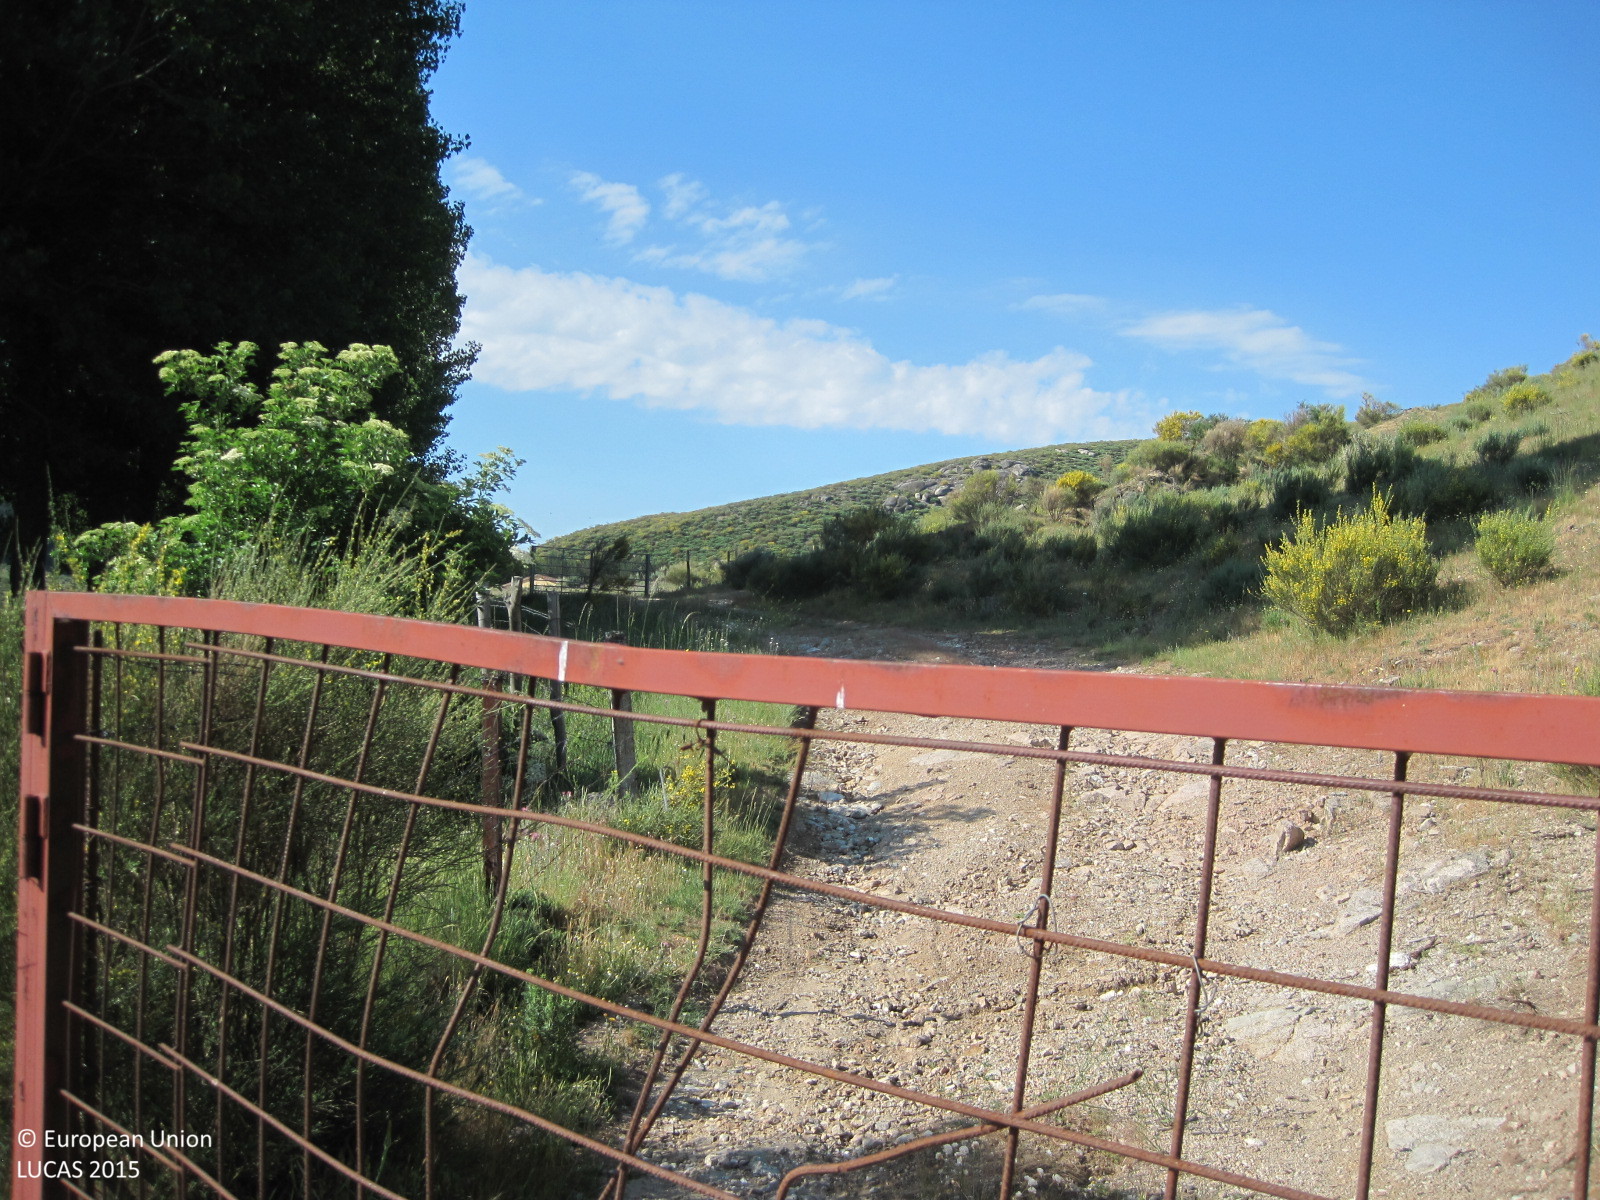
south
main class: Shrubland
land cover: Shrubland without tree cover
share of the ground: > 75 %
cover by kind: shrubs 100 %
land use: Agriculture (excluding fallow land and kitchen gardens)
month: June
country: ES
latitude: 40.3699
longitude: -5.0256
